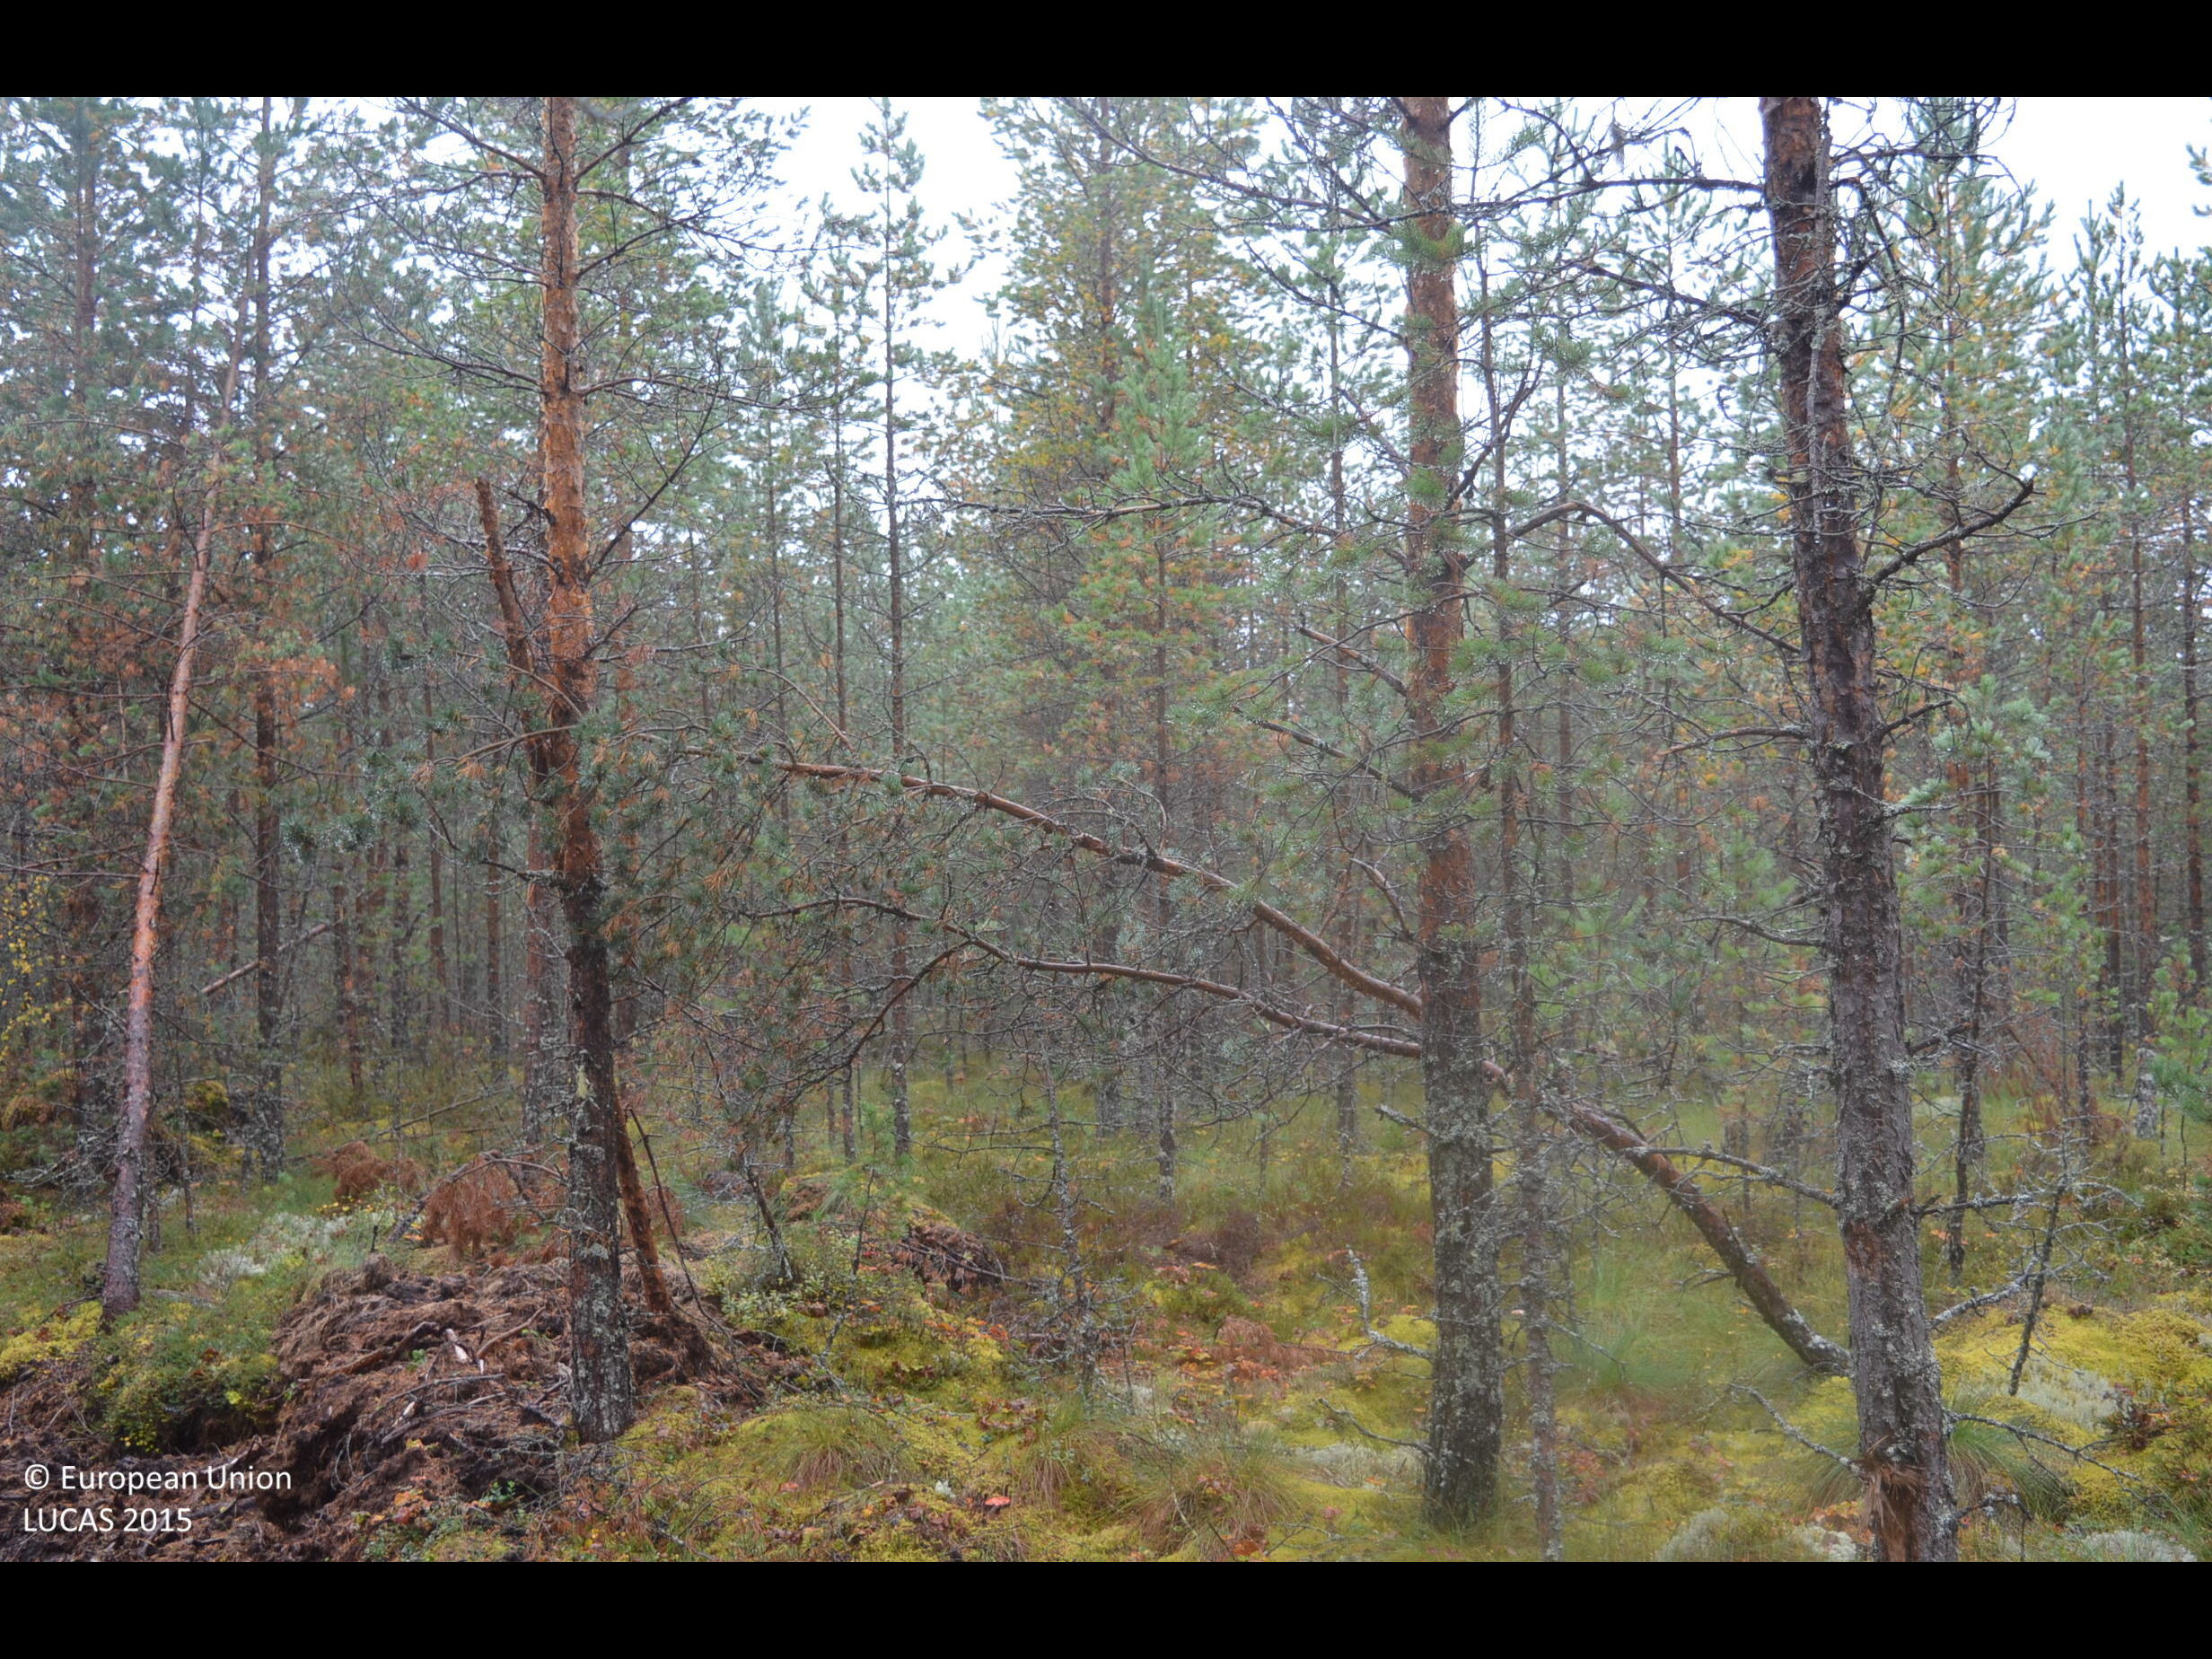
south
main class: Woodland
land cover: Pine dominated coniferous woodland
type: boreal forest
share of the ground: > 75 %
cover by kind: coniferous forest trees 70 %, shrubs 10 %, lichens and mosses 10 %, broadleaved forest trees 5 %, herbaceous plants 5 %
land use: Forestry
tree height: < 5 m
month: September
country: FI
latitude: 62.9487
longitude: 23.9702
